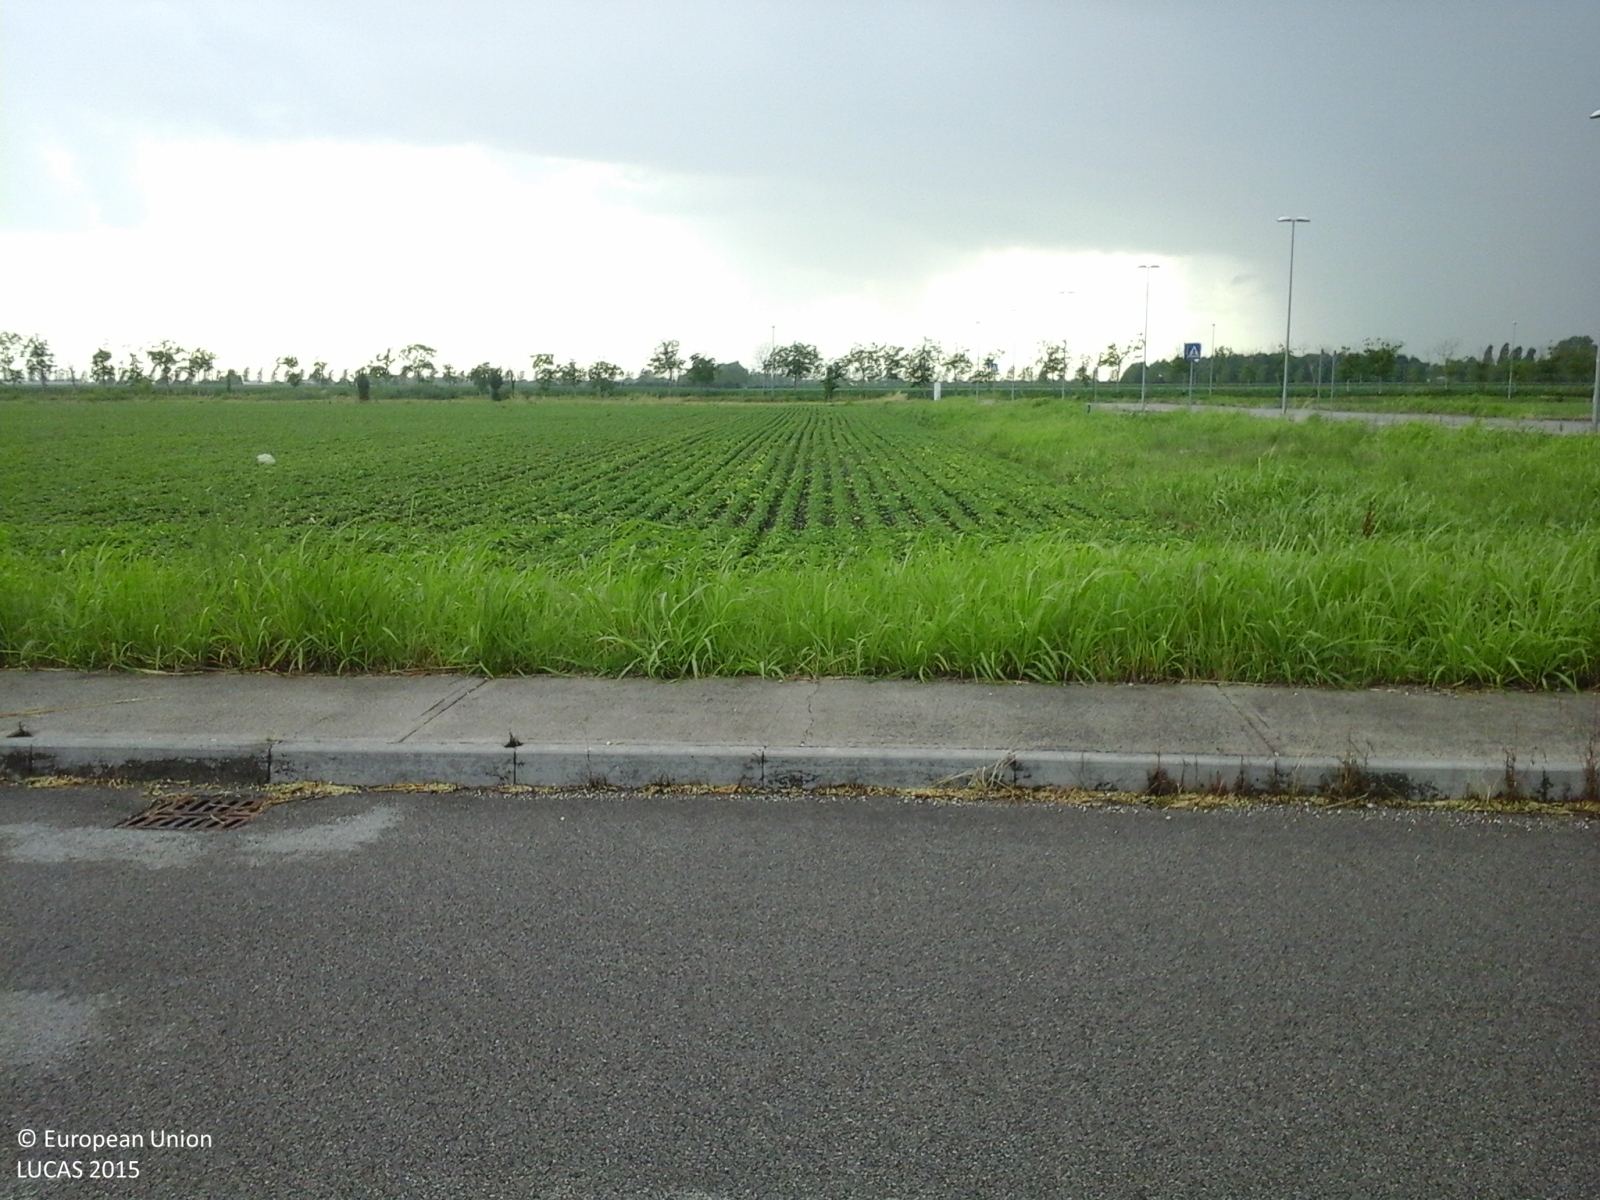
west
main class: Cropland
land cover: Soya
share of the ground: > 75 %
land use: Agriculture (excluding fallow land and kitchen gardens)
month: June
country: IT
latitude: 45.6328
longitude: 12.6772
